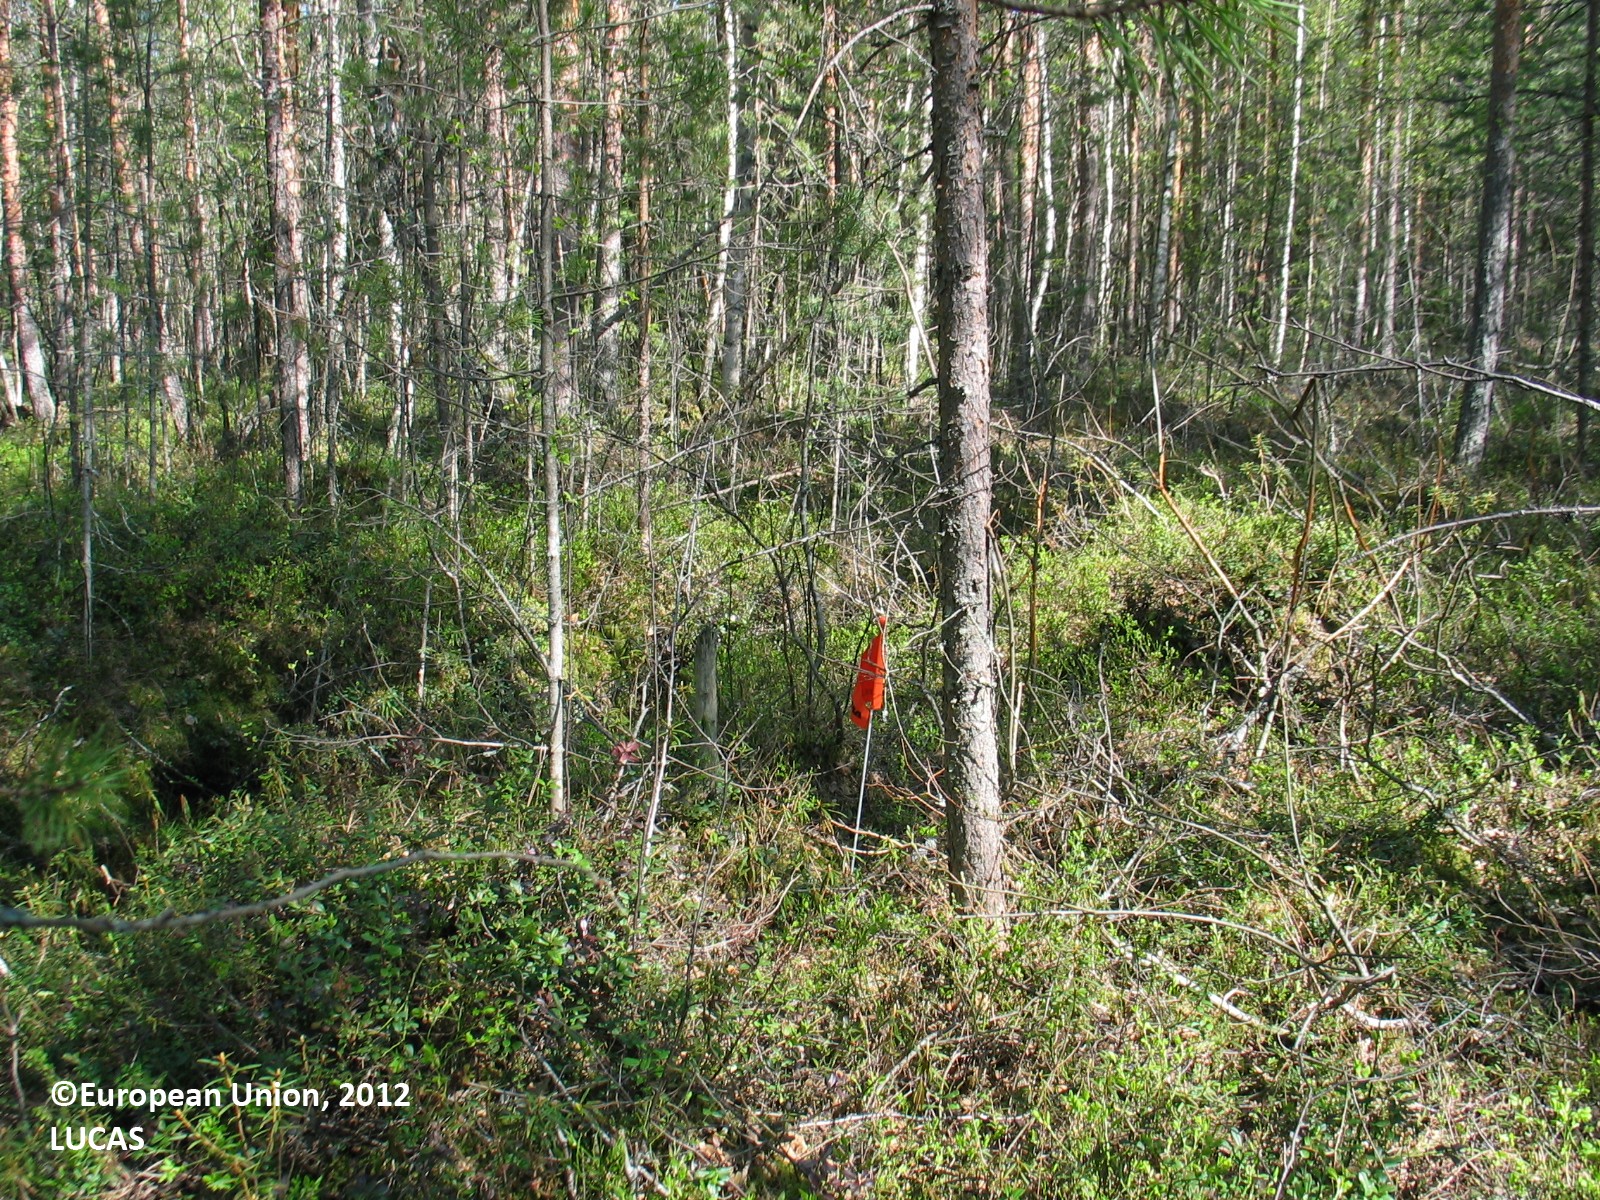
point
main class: Woodland
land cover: Other mixed woodland
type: mire and swamp forests
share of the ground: 50 - 75 %
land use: Forestry
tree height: > 5 m
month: May
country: FI
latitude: 64.9654
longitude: 25.2647
